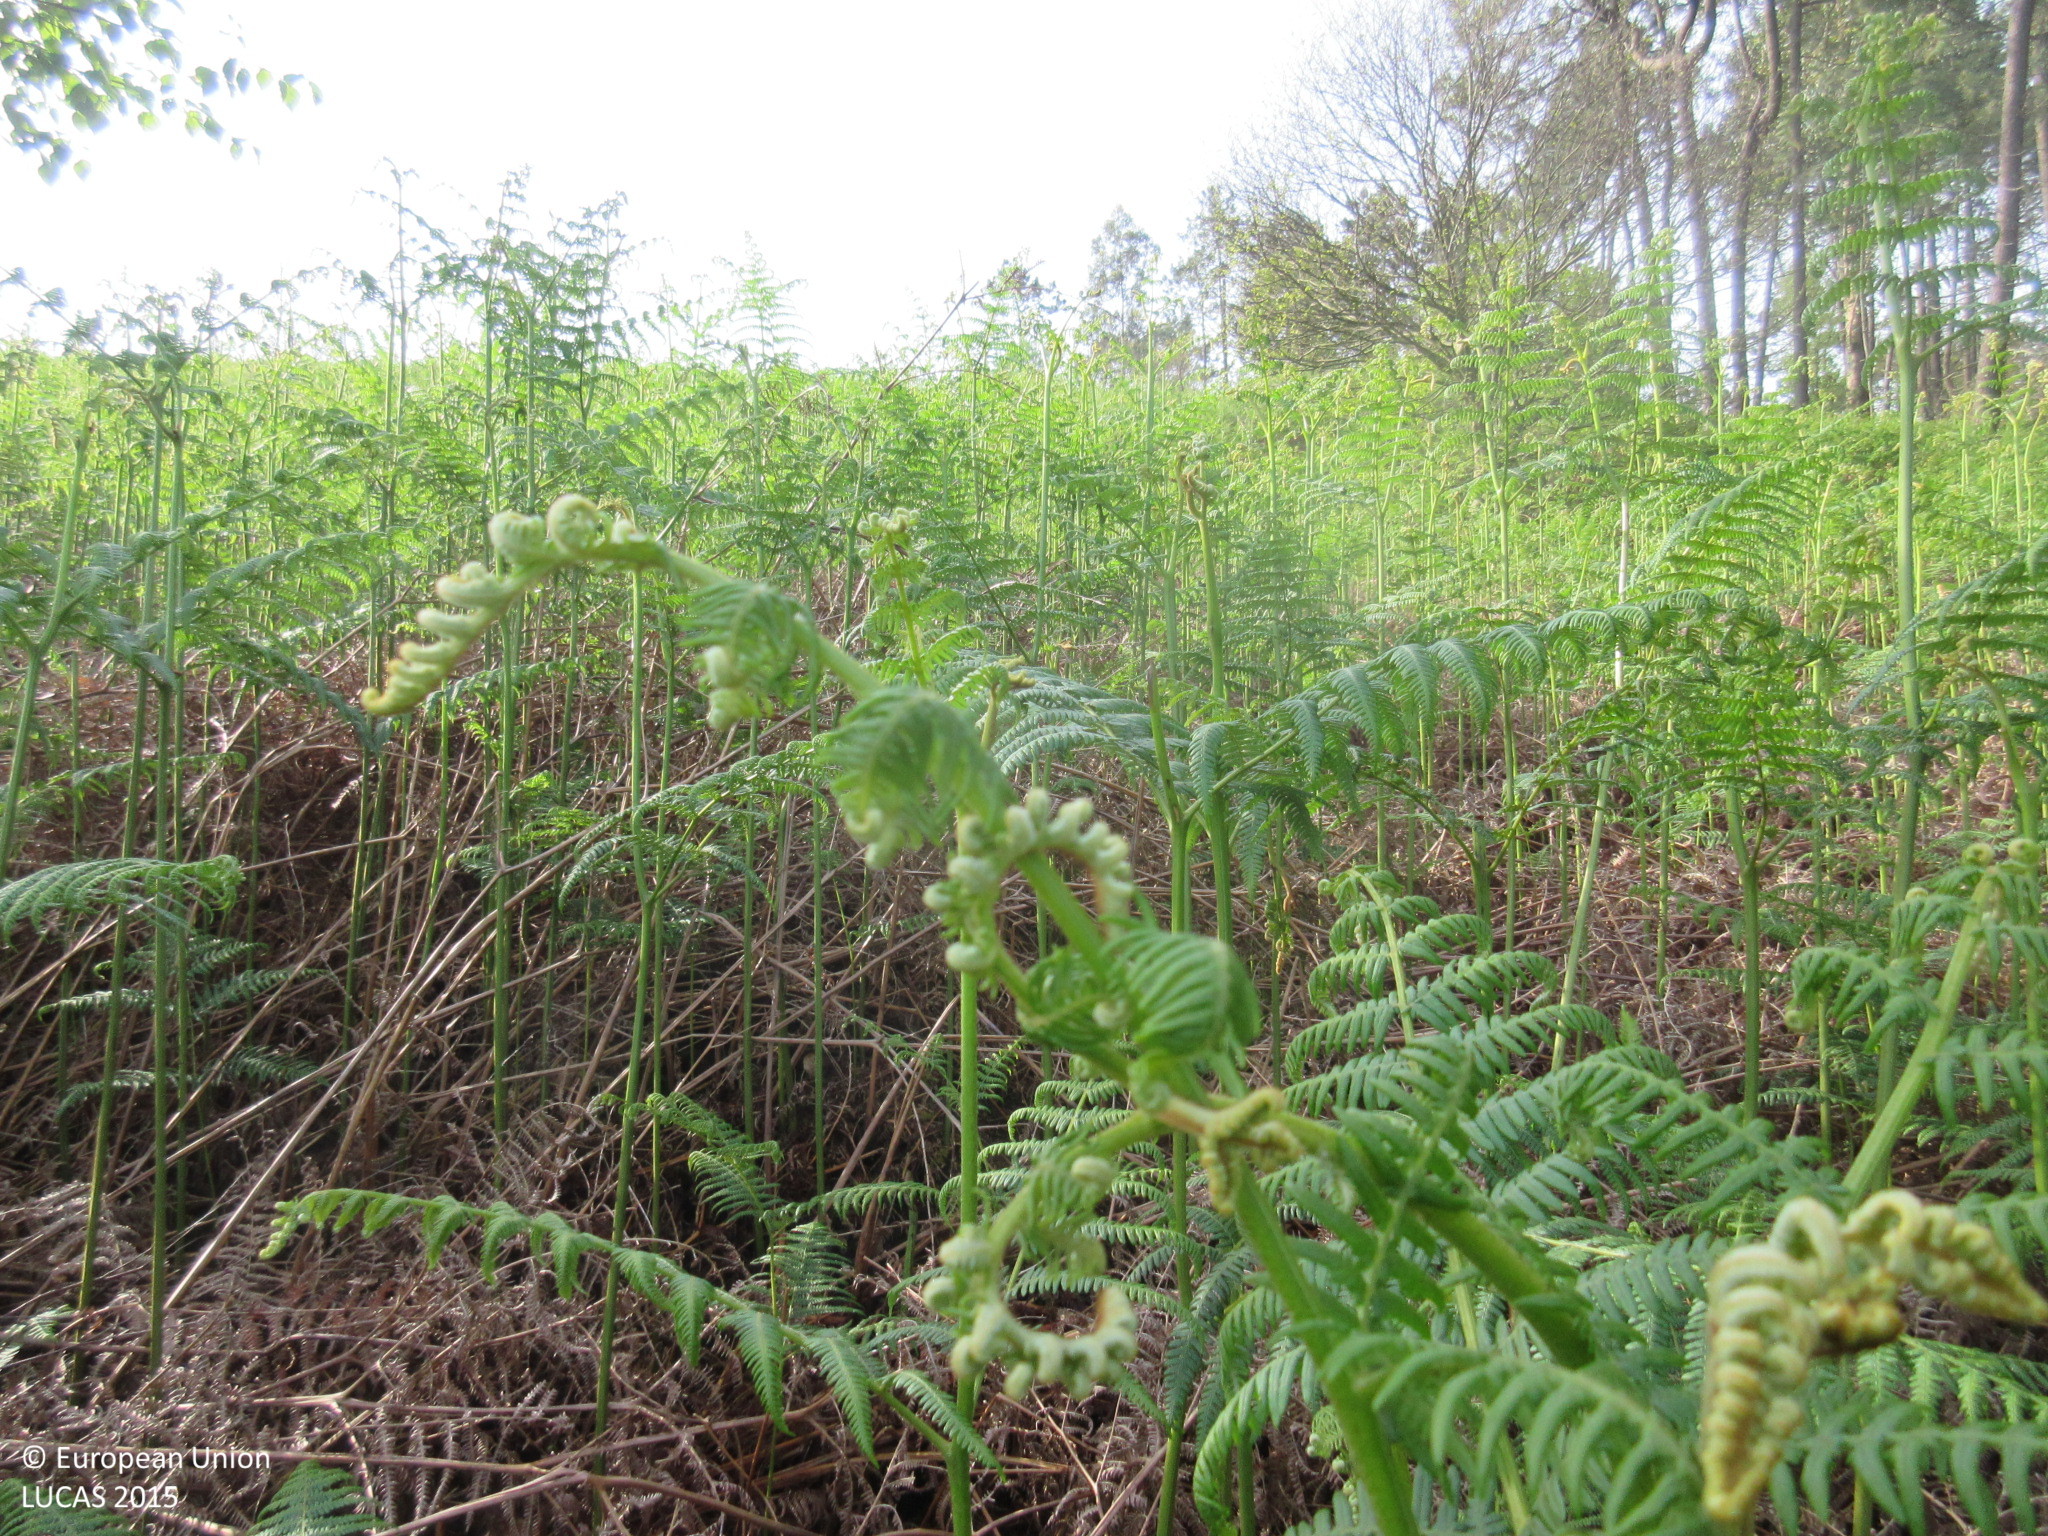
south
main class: Shrubland
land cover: Shrubland without tree cover
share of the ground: > 75 %
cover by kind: shrubs 100 %
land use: Semi-natural and natural areas not in use
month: April
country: ES
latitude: 43.5189
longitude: -6.6998
